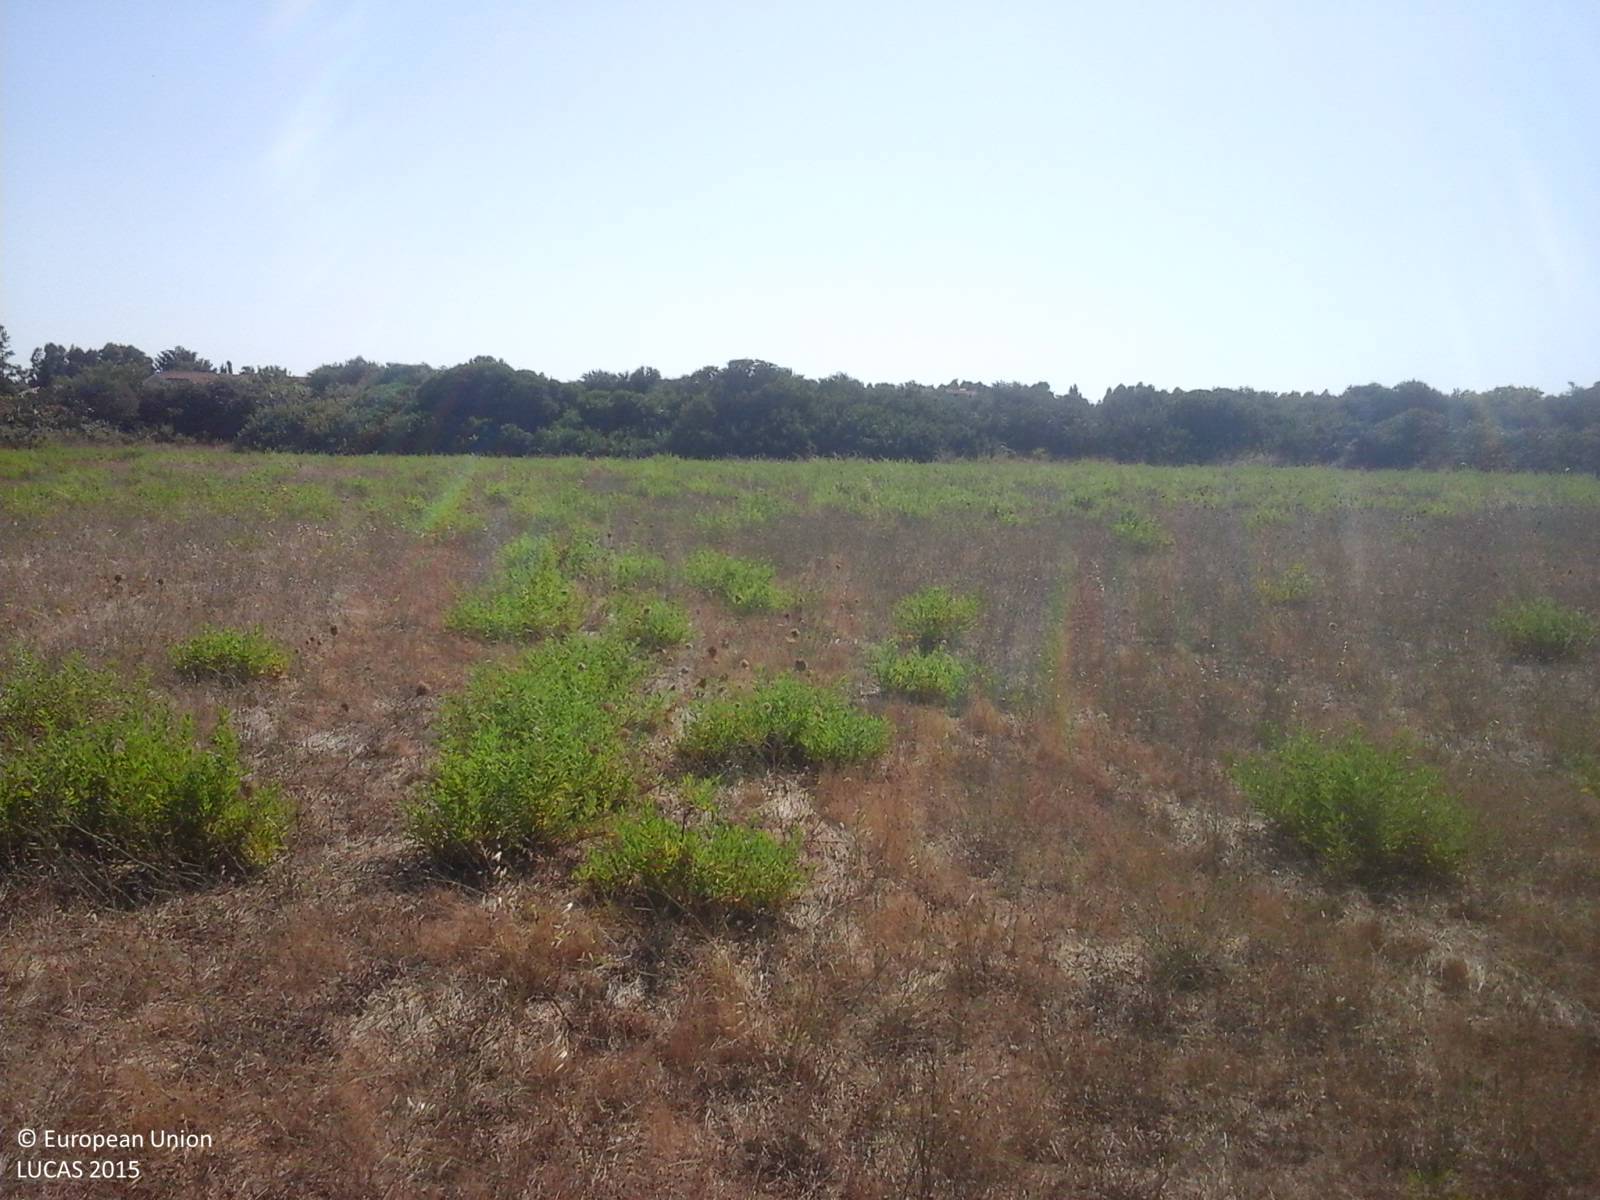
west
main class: Grassland
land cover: Grassland without tree/shrub cover
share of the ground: > 75 %
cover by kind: herbaceous plants 85 %, unconsolidated bare surface 10 %, shrubs 5 %
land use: Agriculture (excluding fallow land and kitchen gardens)
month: July
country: IT
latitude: 39.1148
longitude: 8.5174
